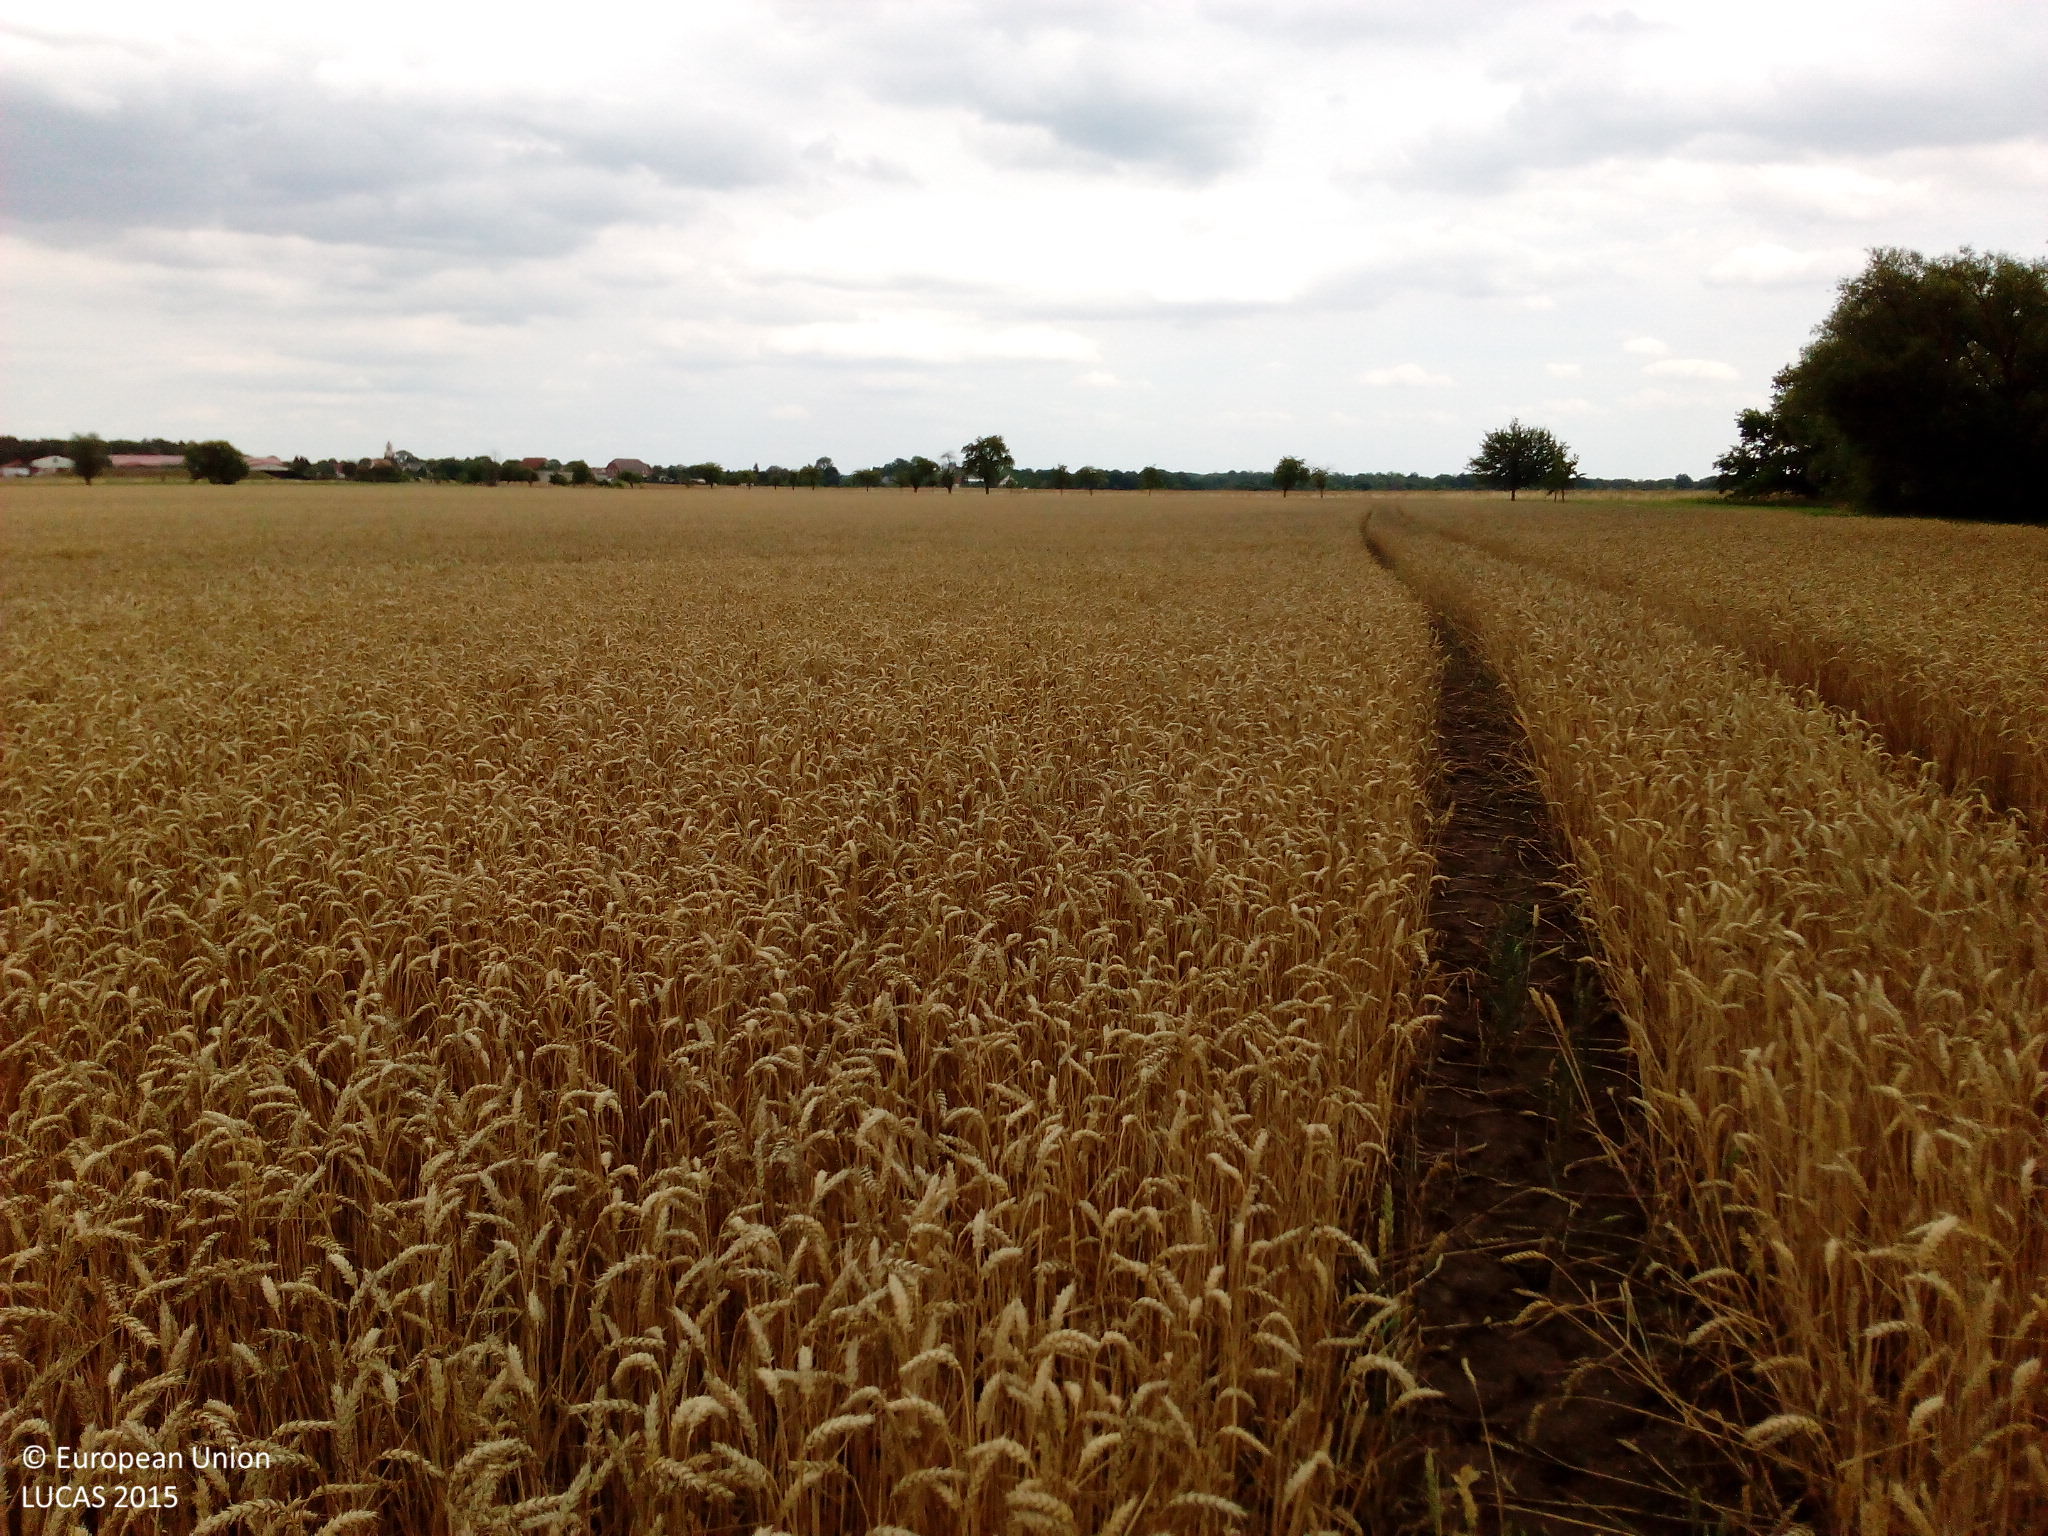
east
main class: Cropland
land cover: Common wheat
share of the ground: > 75 %
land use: Agriculture (excluding fallow land and kitchen gardens)
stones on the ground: < 10 %
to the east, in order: Common wheat
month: July
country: DE
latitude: 52.0596
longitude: 11.7060
